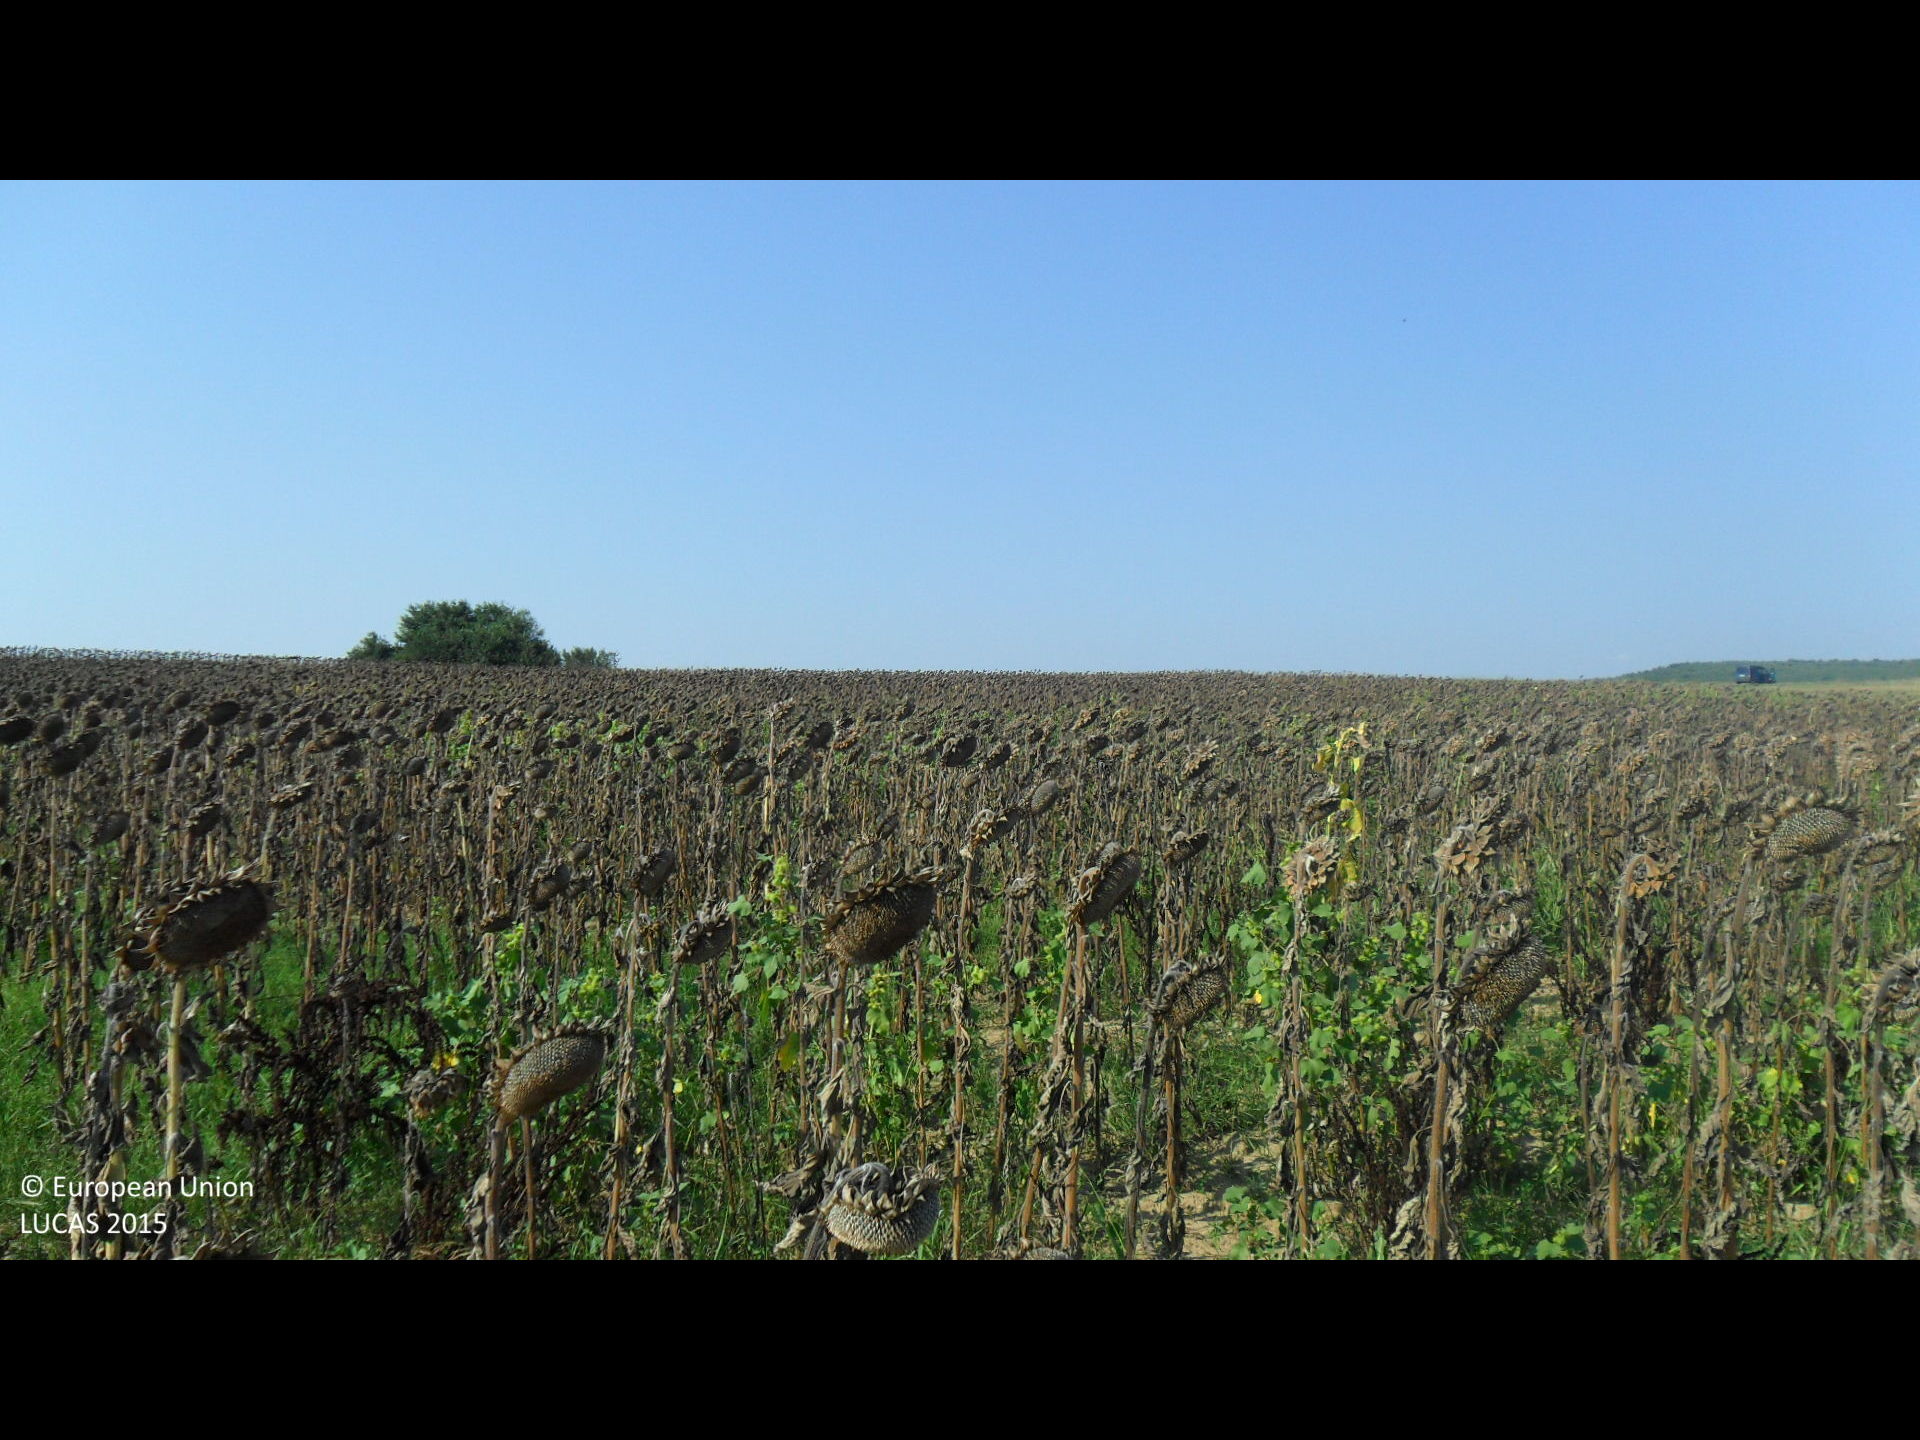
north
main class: Cropland
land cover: Sunflower
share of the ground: > 75 %
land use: Agriculture (excluding fallow land and kitchen gardens)
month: September
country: BG
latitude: 43.0643
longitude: 26.6687
